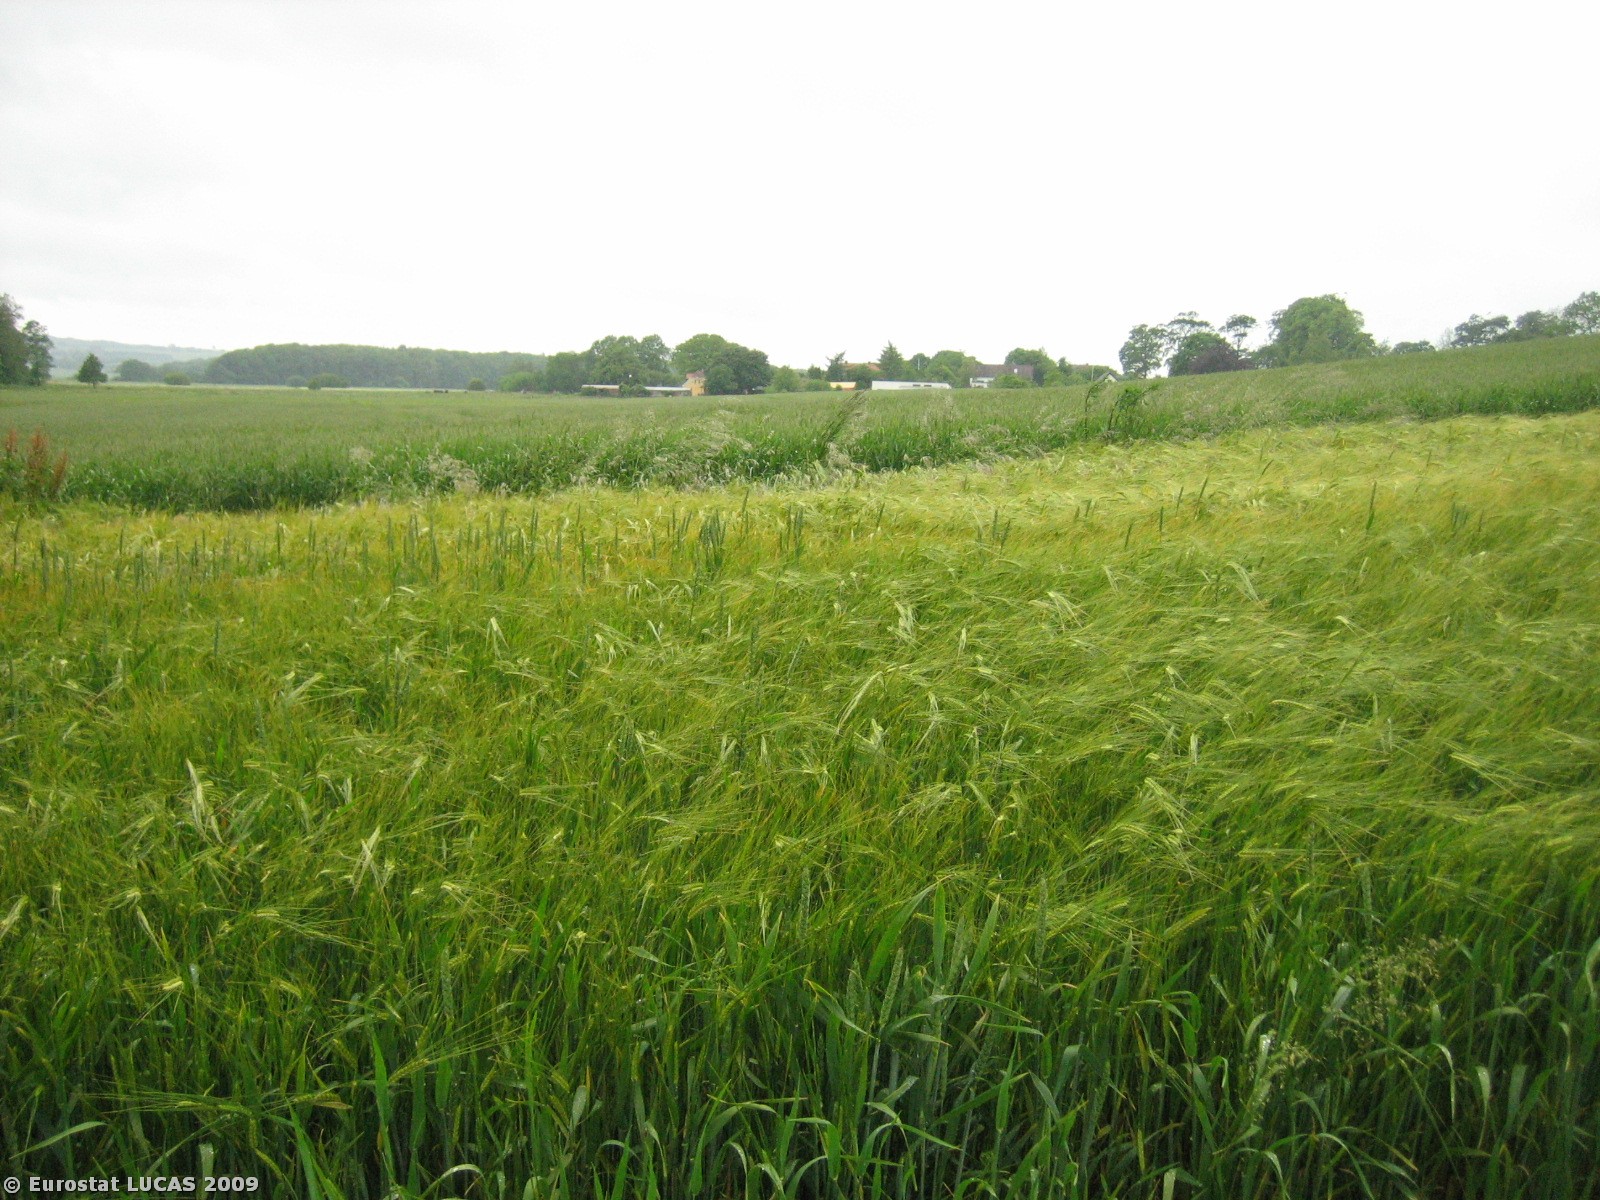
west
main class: Cropland
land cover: Barley
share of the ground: > 75 %
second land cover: Common wheat
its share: < 10 %
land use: Agriculture (excluding fallow land and kitchen gardens)
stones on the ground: < 10 %
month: June
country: DK
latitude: 55.9900
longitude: 10.0160
